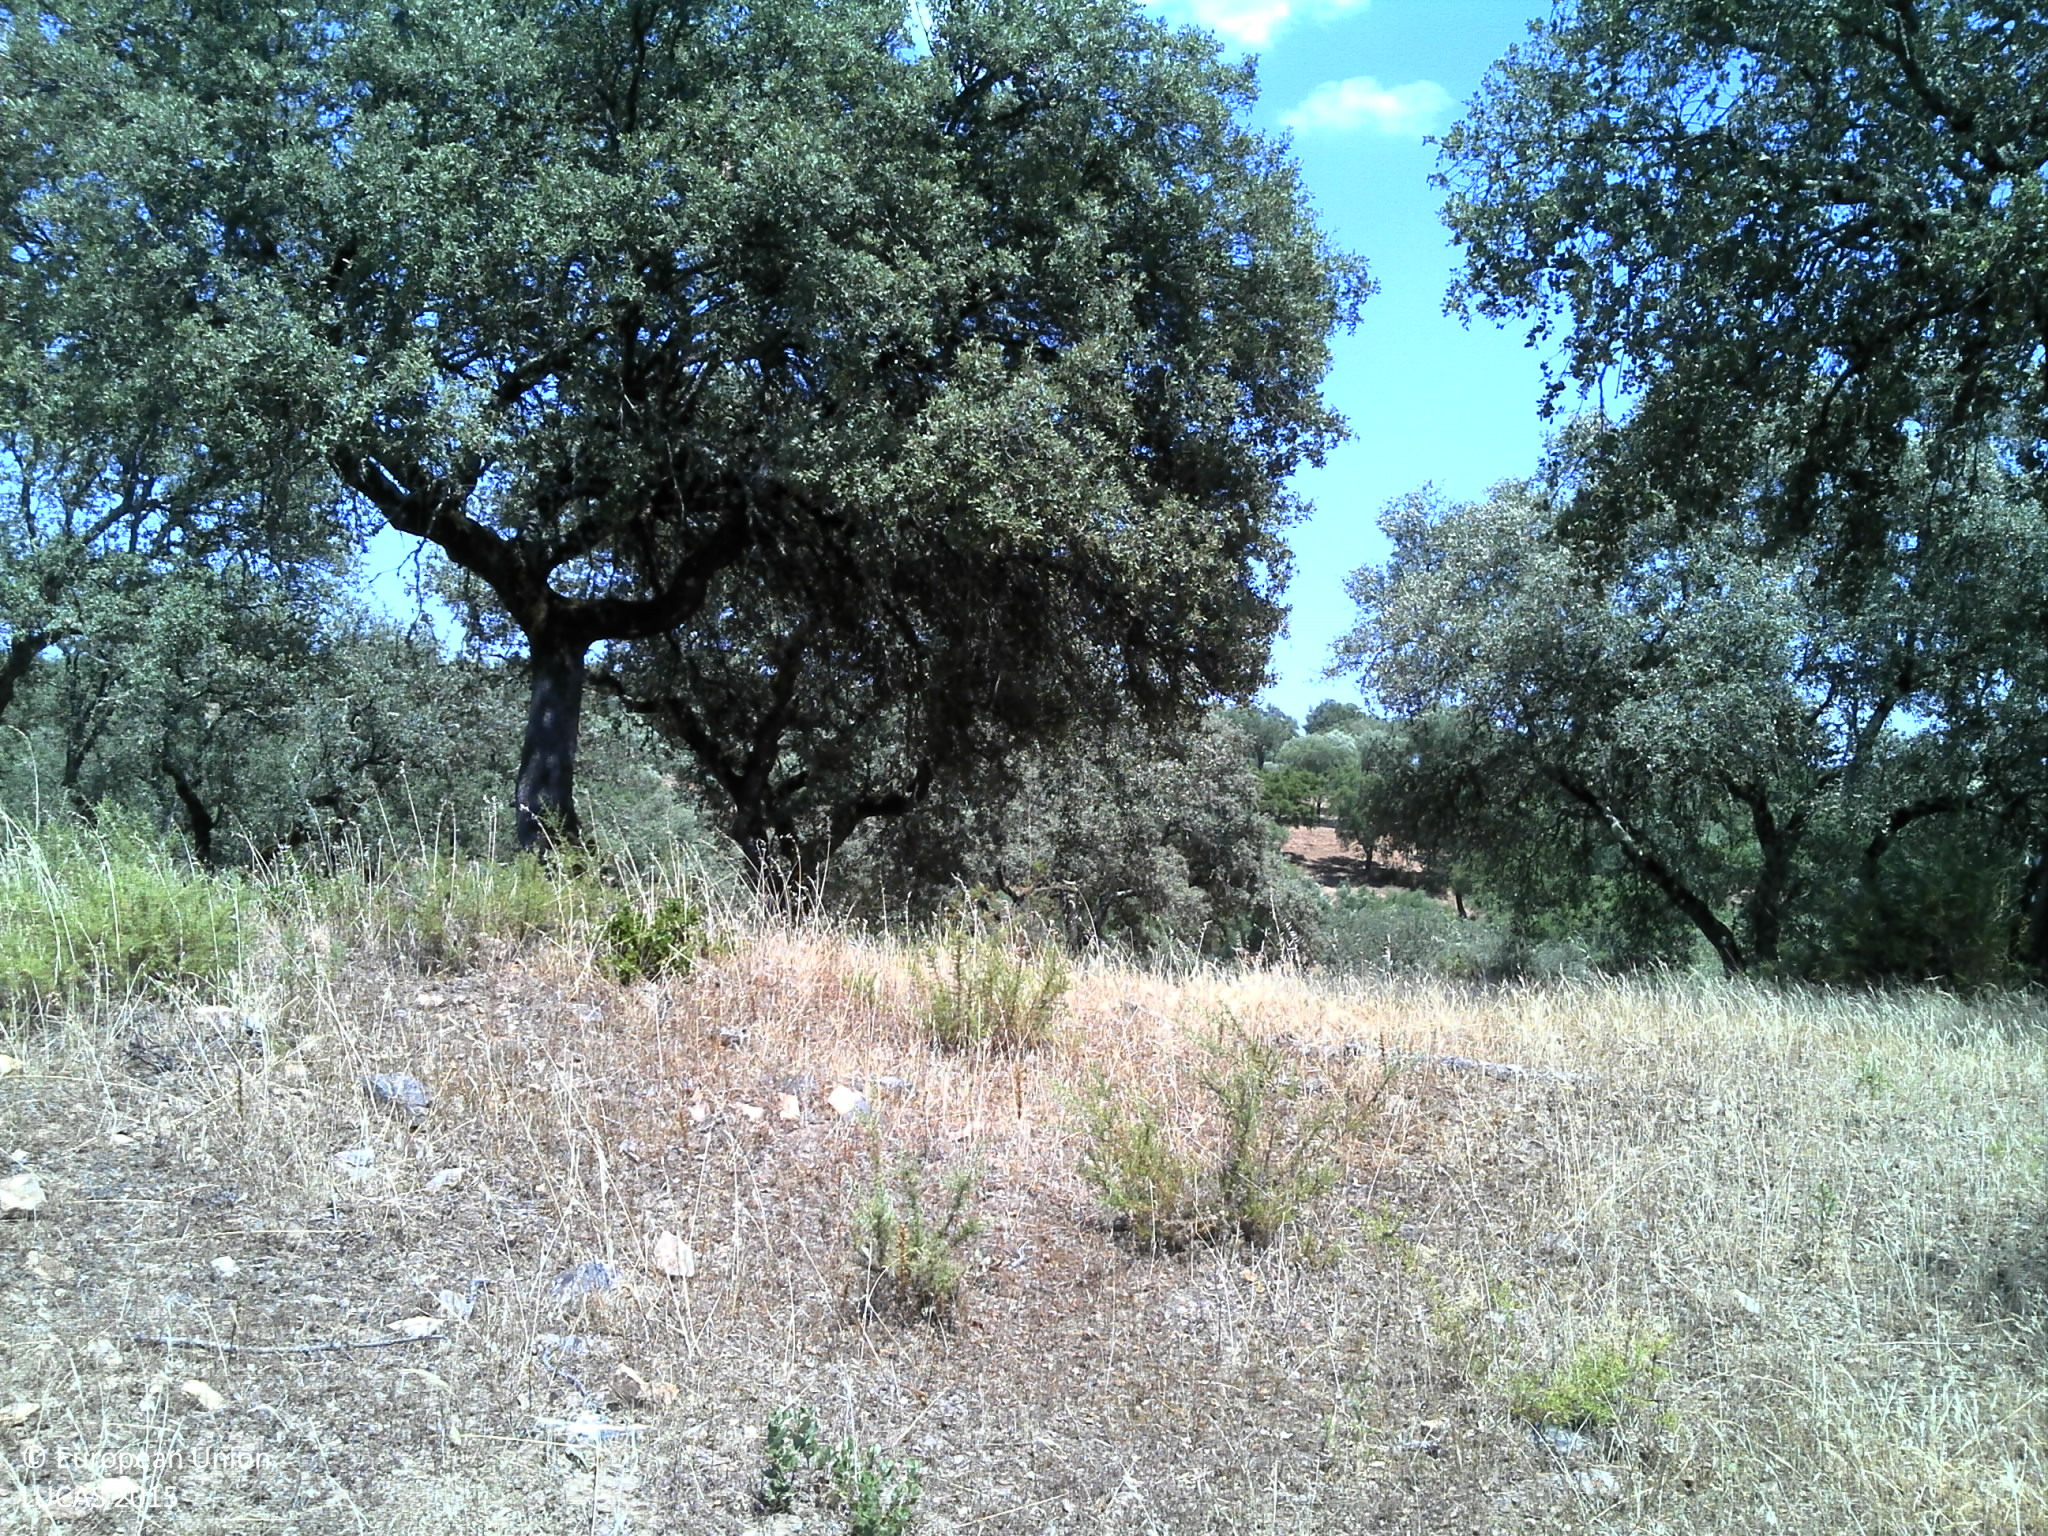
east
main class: Woodland
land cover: Broadleaved woodland
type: broadleaved evergreen forest
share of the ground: 25 - 50 %
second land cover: Shrubland without tree cover
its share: 25 - 50 %
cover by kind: shrubs 50 %, broadleaved forest trees 25 %, unconsolidated bare surface 15 %, herbaceous plants 10 %
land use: Forestry
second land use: Agriculture (excluding fallow land and kitchen gardens)
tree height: > 5 m
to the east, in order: Broadleaved woodland; Shrubland without tree cover; Broadleaved woodland; Tracks; Fences; Broadleaved woodland; Rivers and streams; Fences; Broadleaved woodland
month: June
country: PT
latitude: 38.4239
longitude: -8.1754
